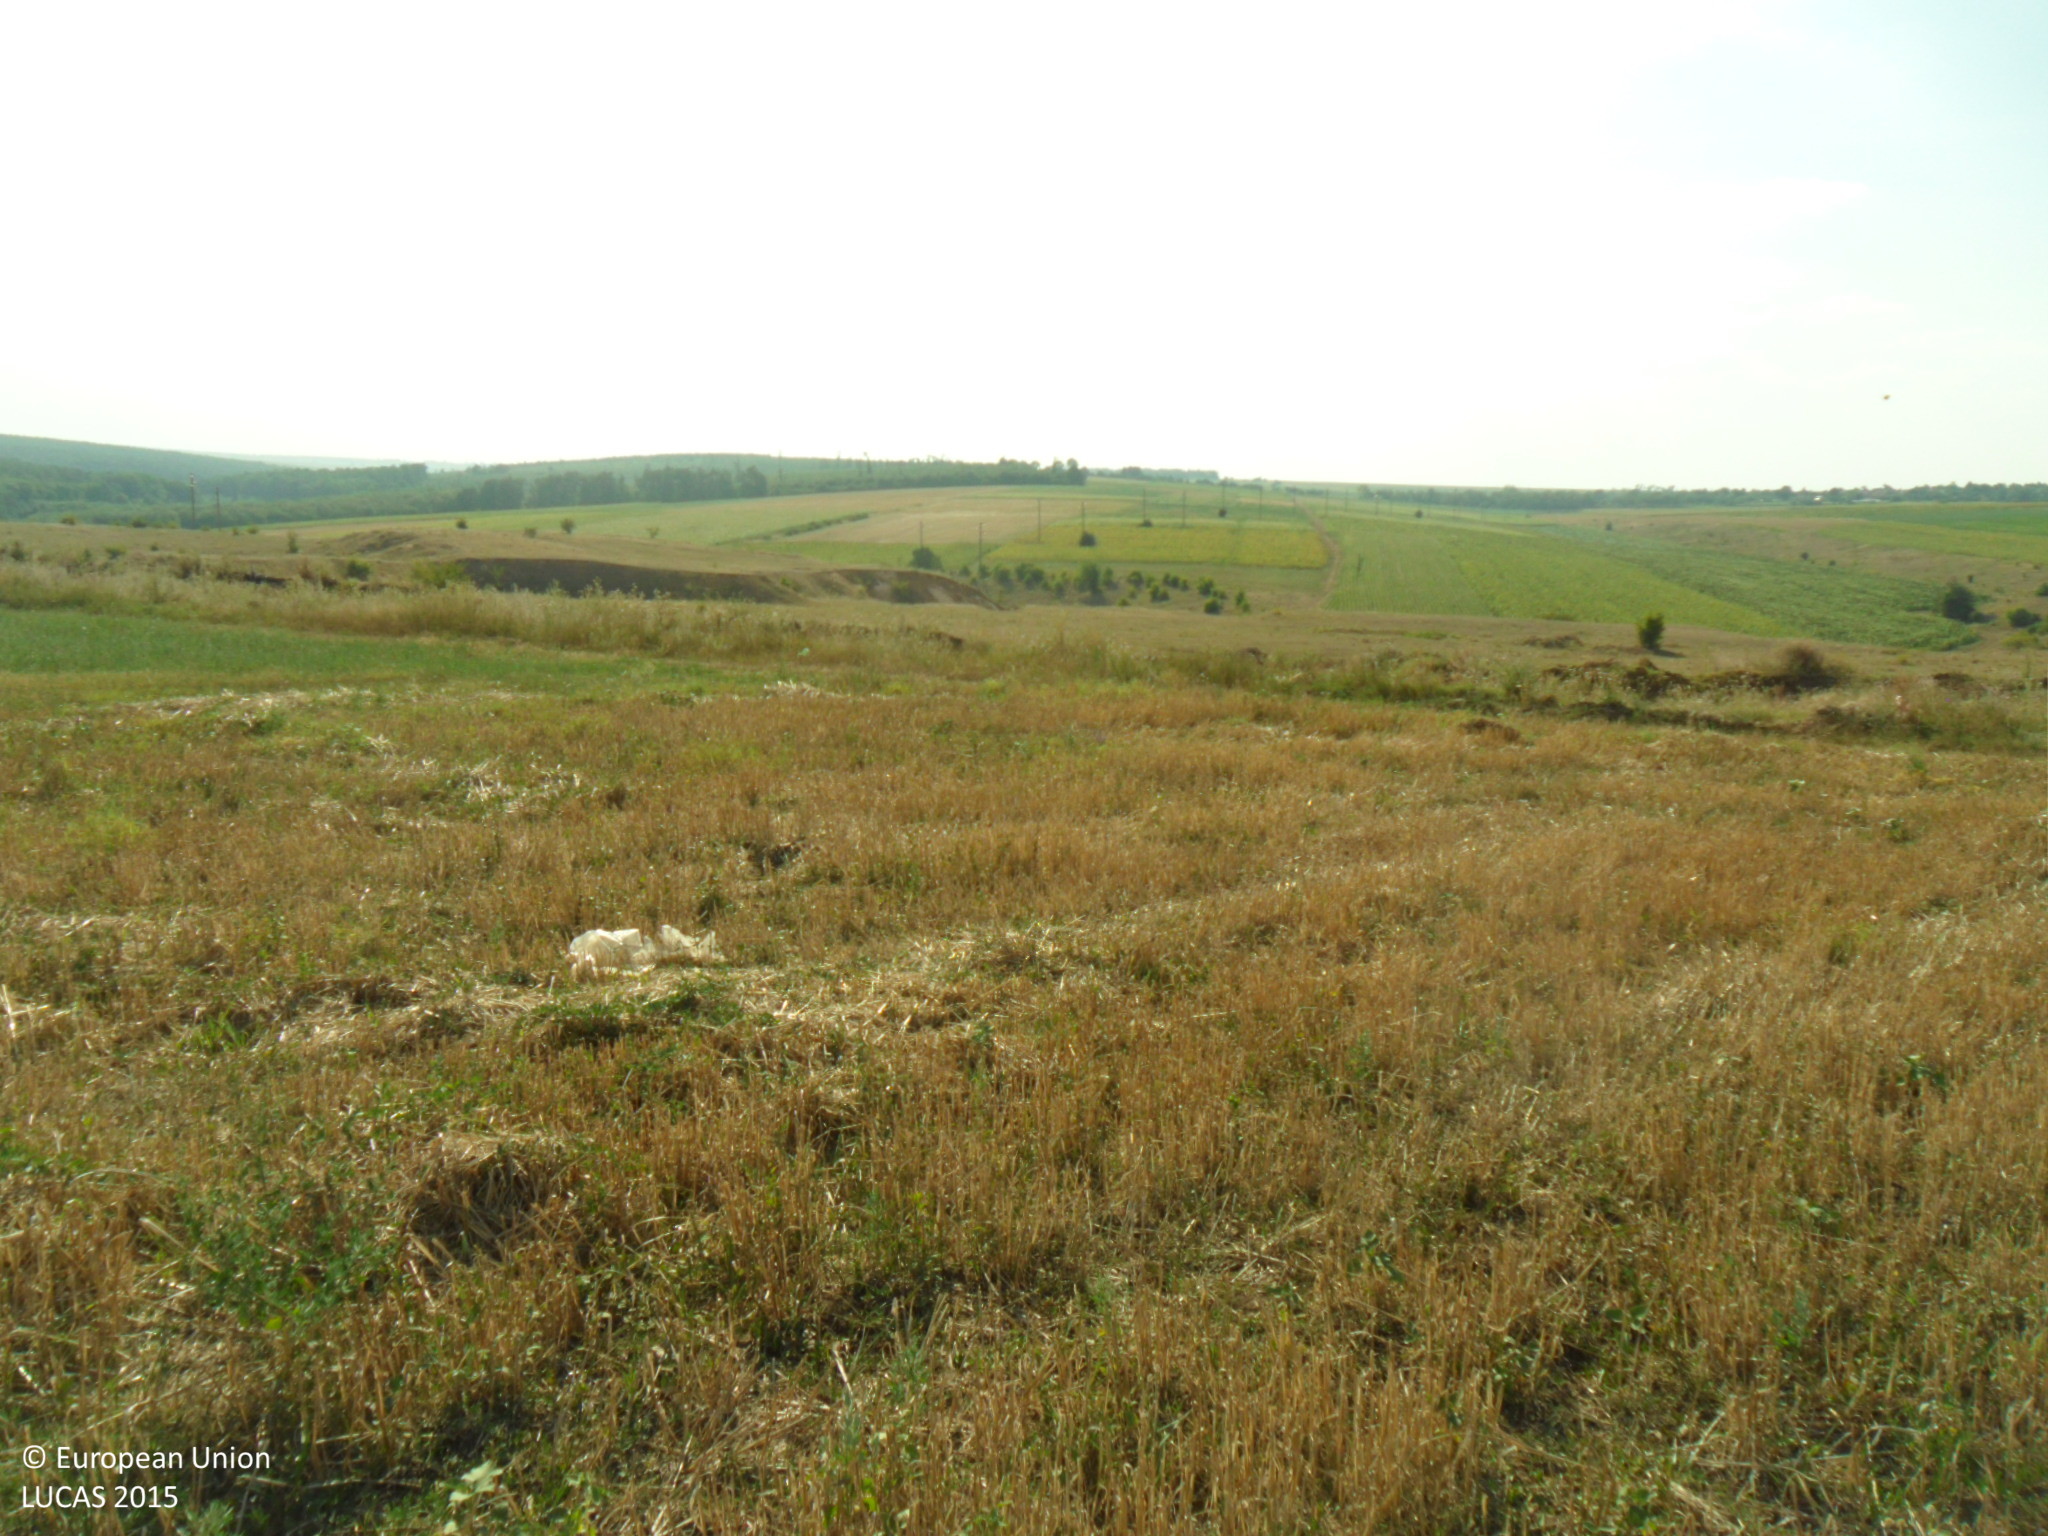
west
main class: Cropland
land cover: Barley
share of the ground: 50 - 75 %
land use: Agriculture (excluding fallow land and kitchen gardens)
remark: Harvested field
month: August
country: BG
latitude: 43.6376
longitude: 27.0911
